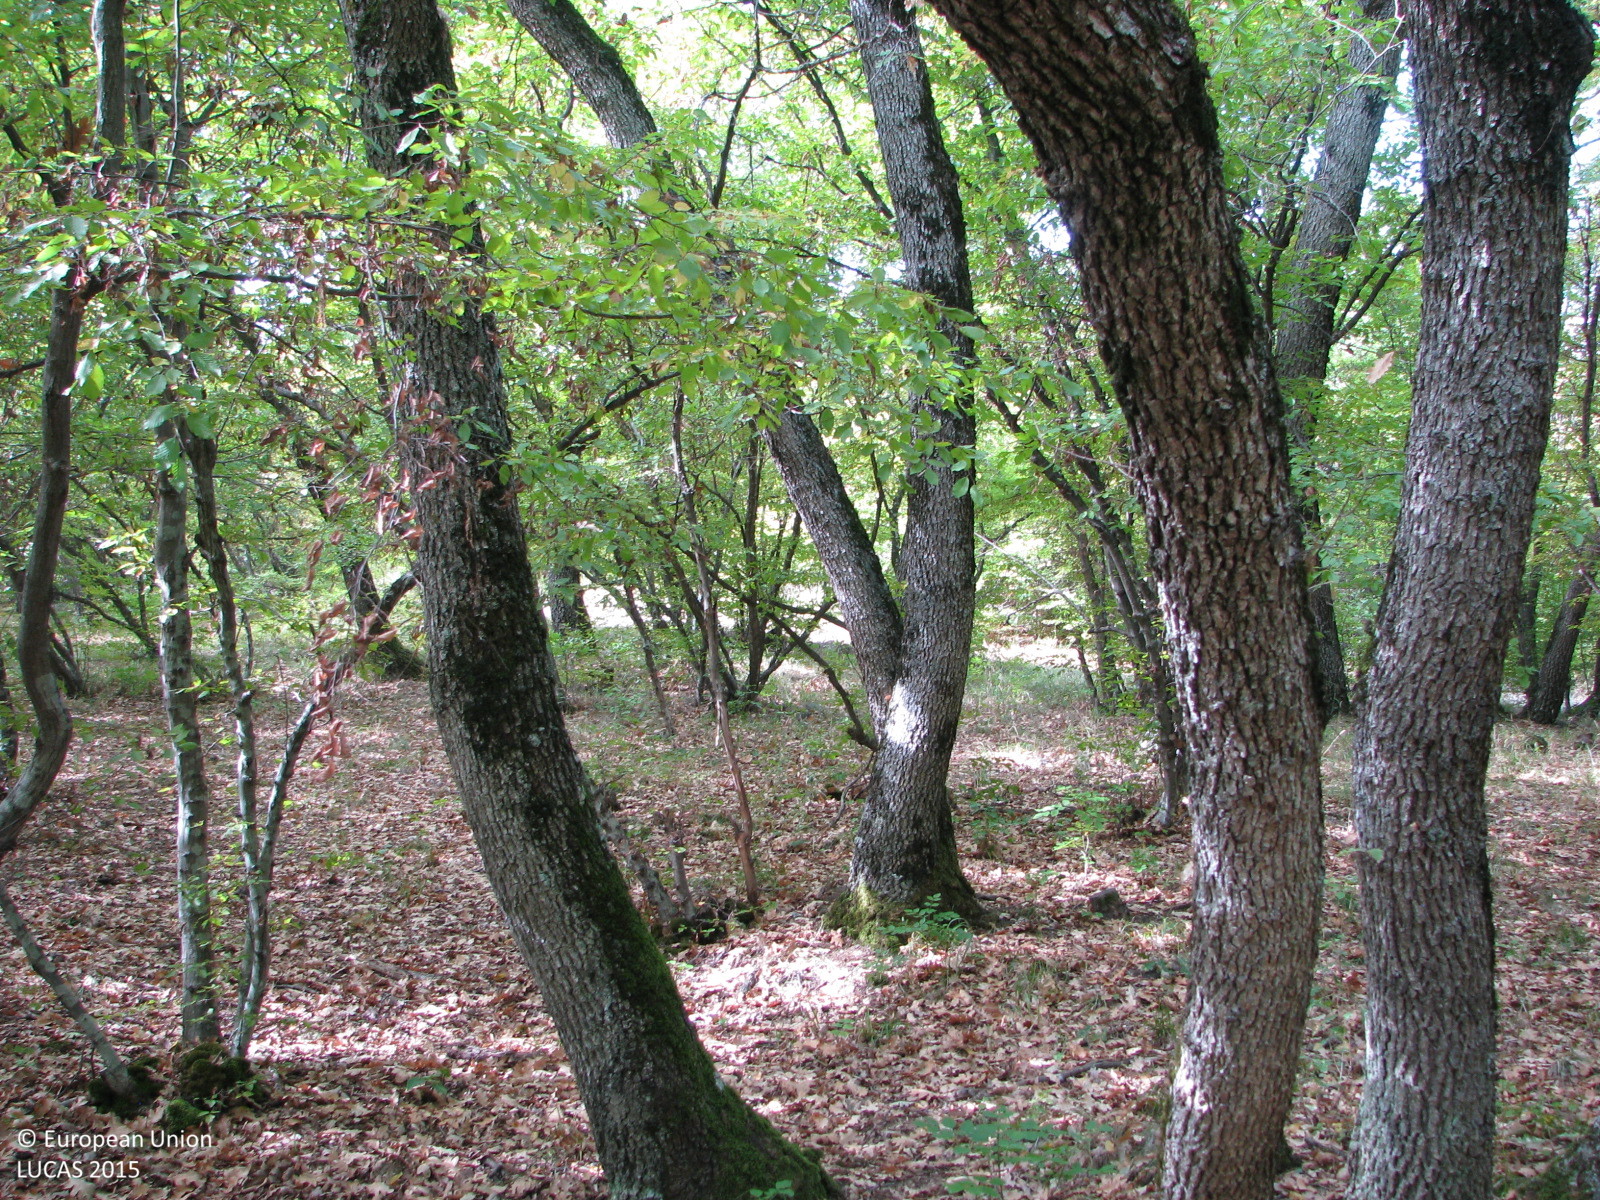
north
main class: Woodland
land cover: Broadleaved woodland
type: mesophytic deciduous forest
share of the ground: 50 - 75 %
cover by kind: broadleaved forest trees 70 %, unconsolidated bare surface 30 %
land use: Forestry
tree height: > 5 m
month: October
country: BG
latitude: 42.5425
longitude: 25.9216
